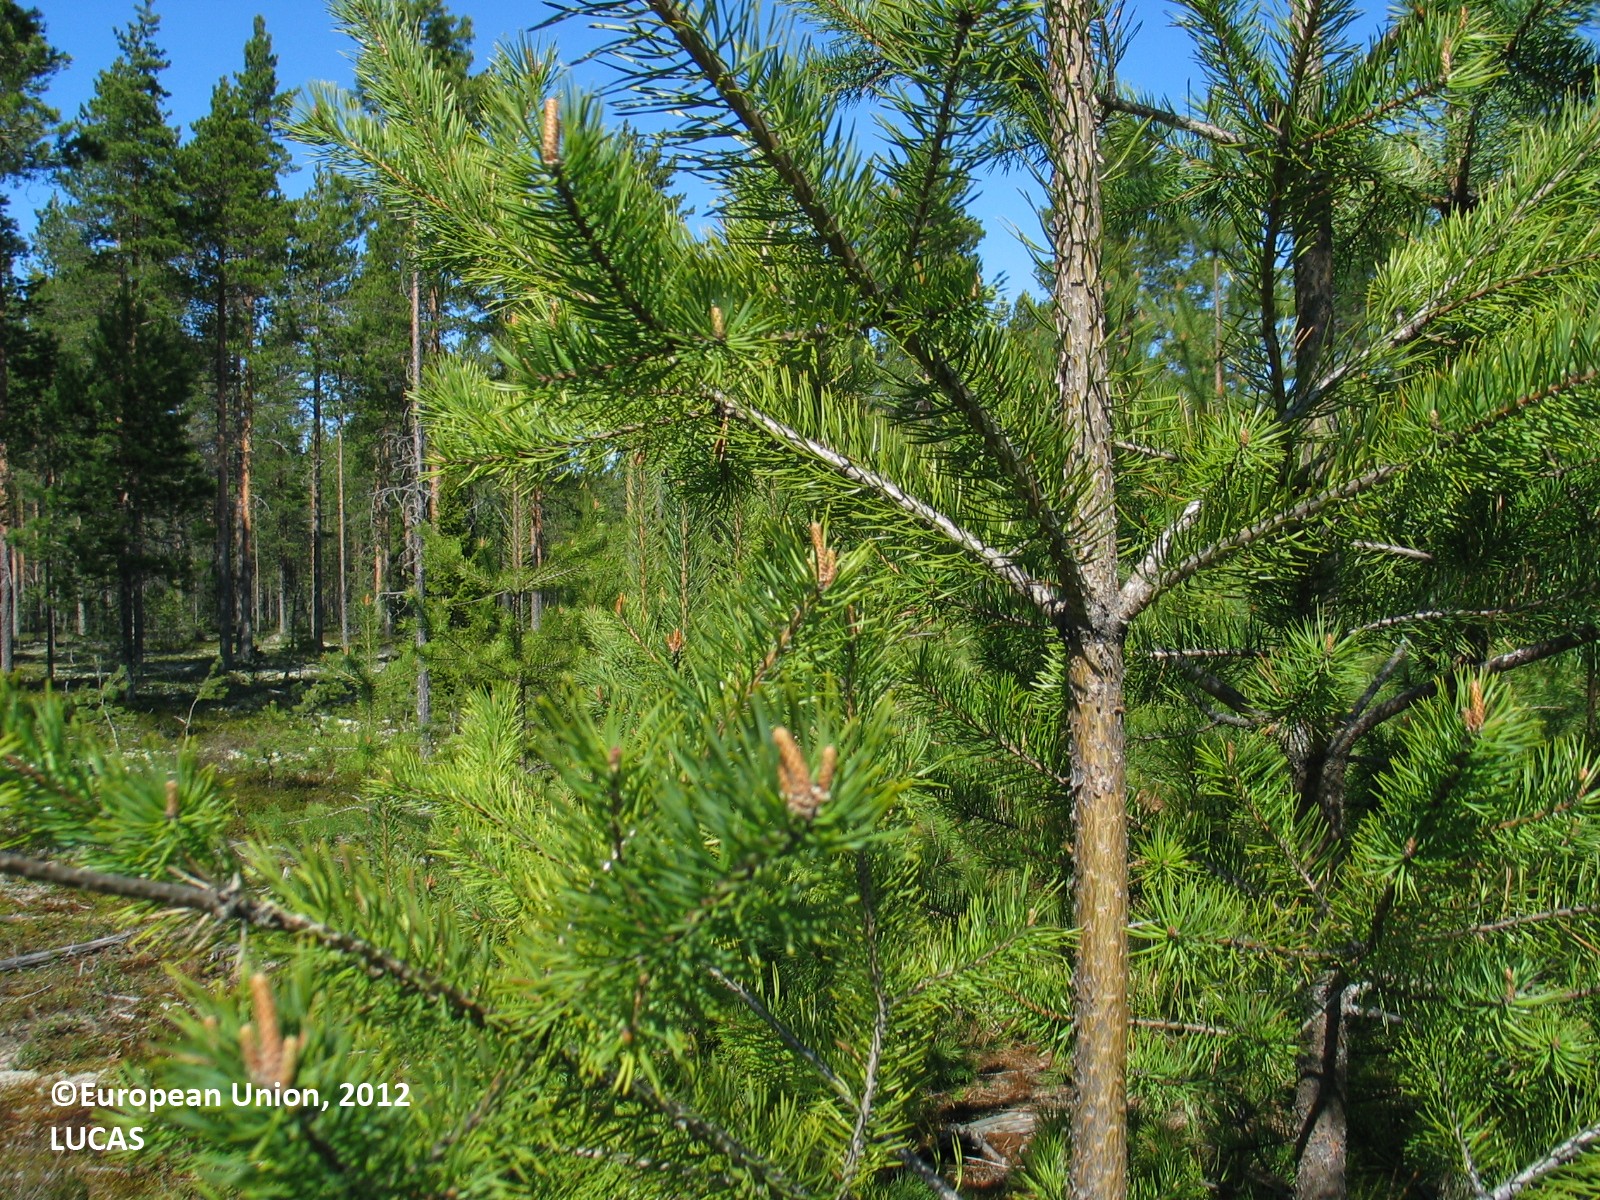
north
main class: Woodland
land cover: Pine dominated coniferous woodland
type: boreal forest
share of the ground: 25 - 50 %
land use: Forestry
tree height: < 5 m
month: May
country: FI
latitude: 64.9440
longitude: 25.2958
